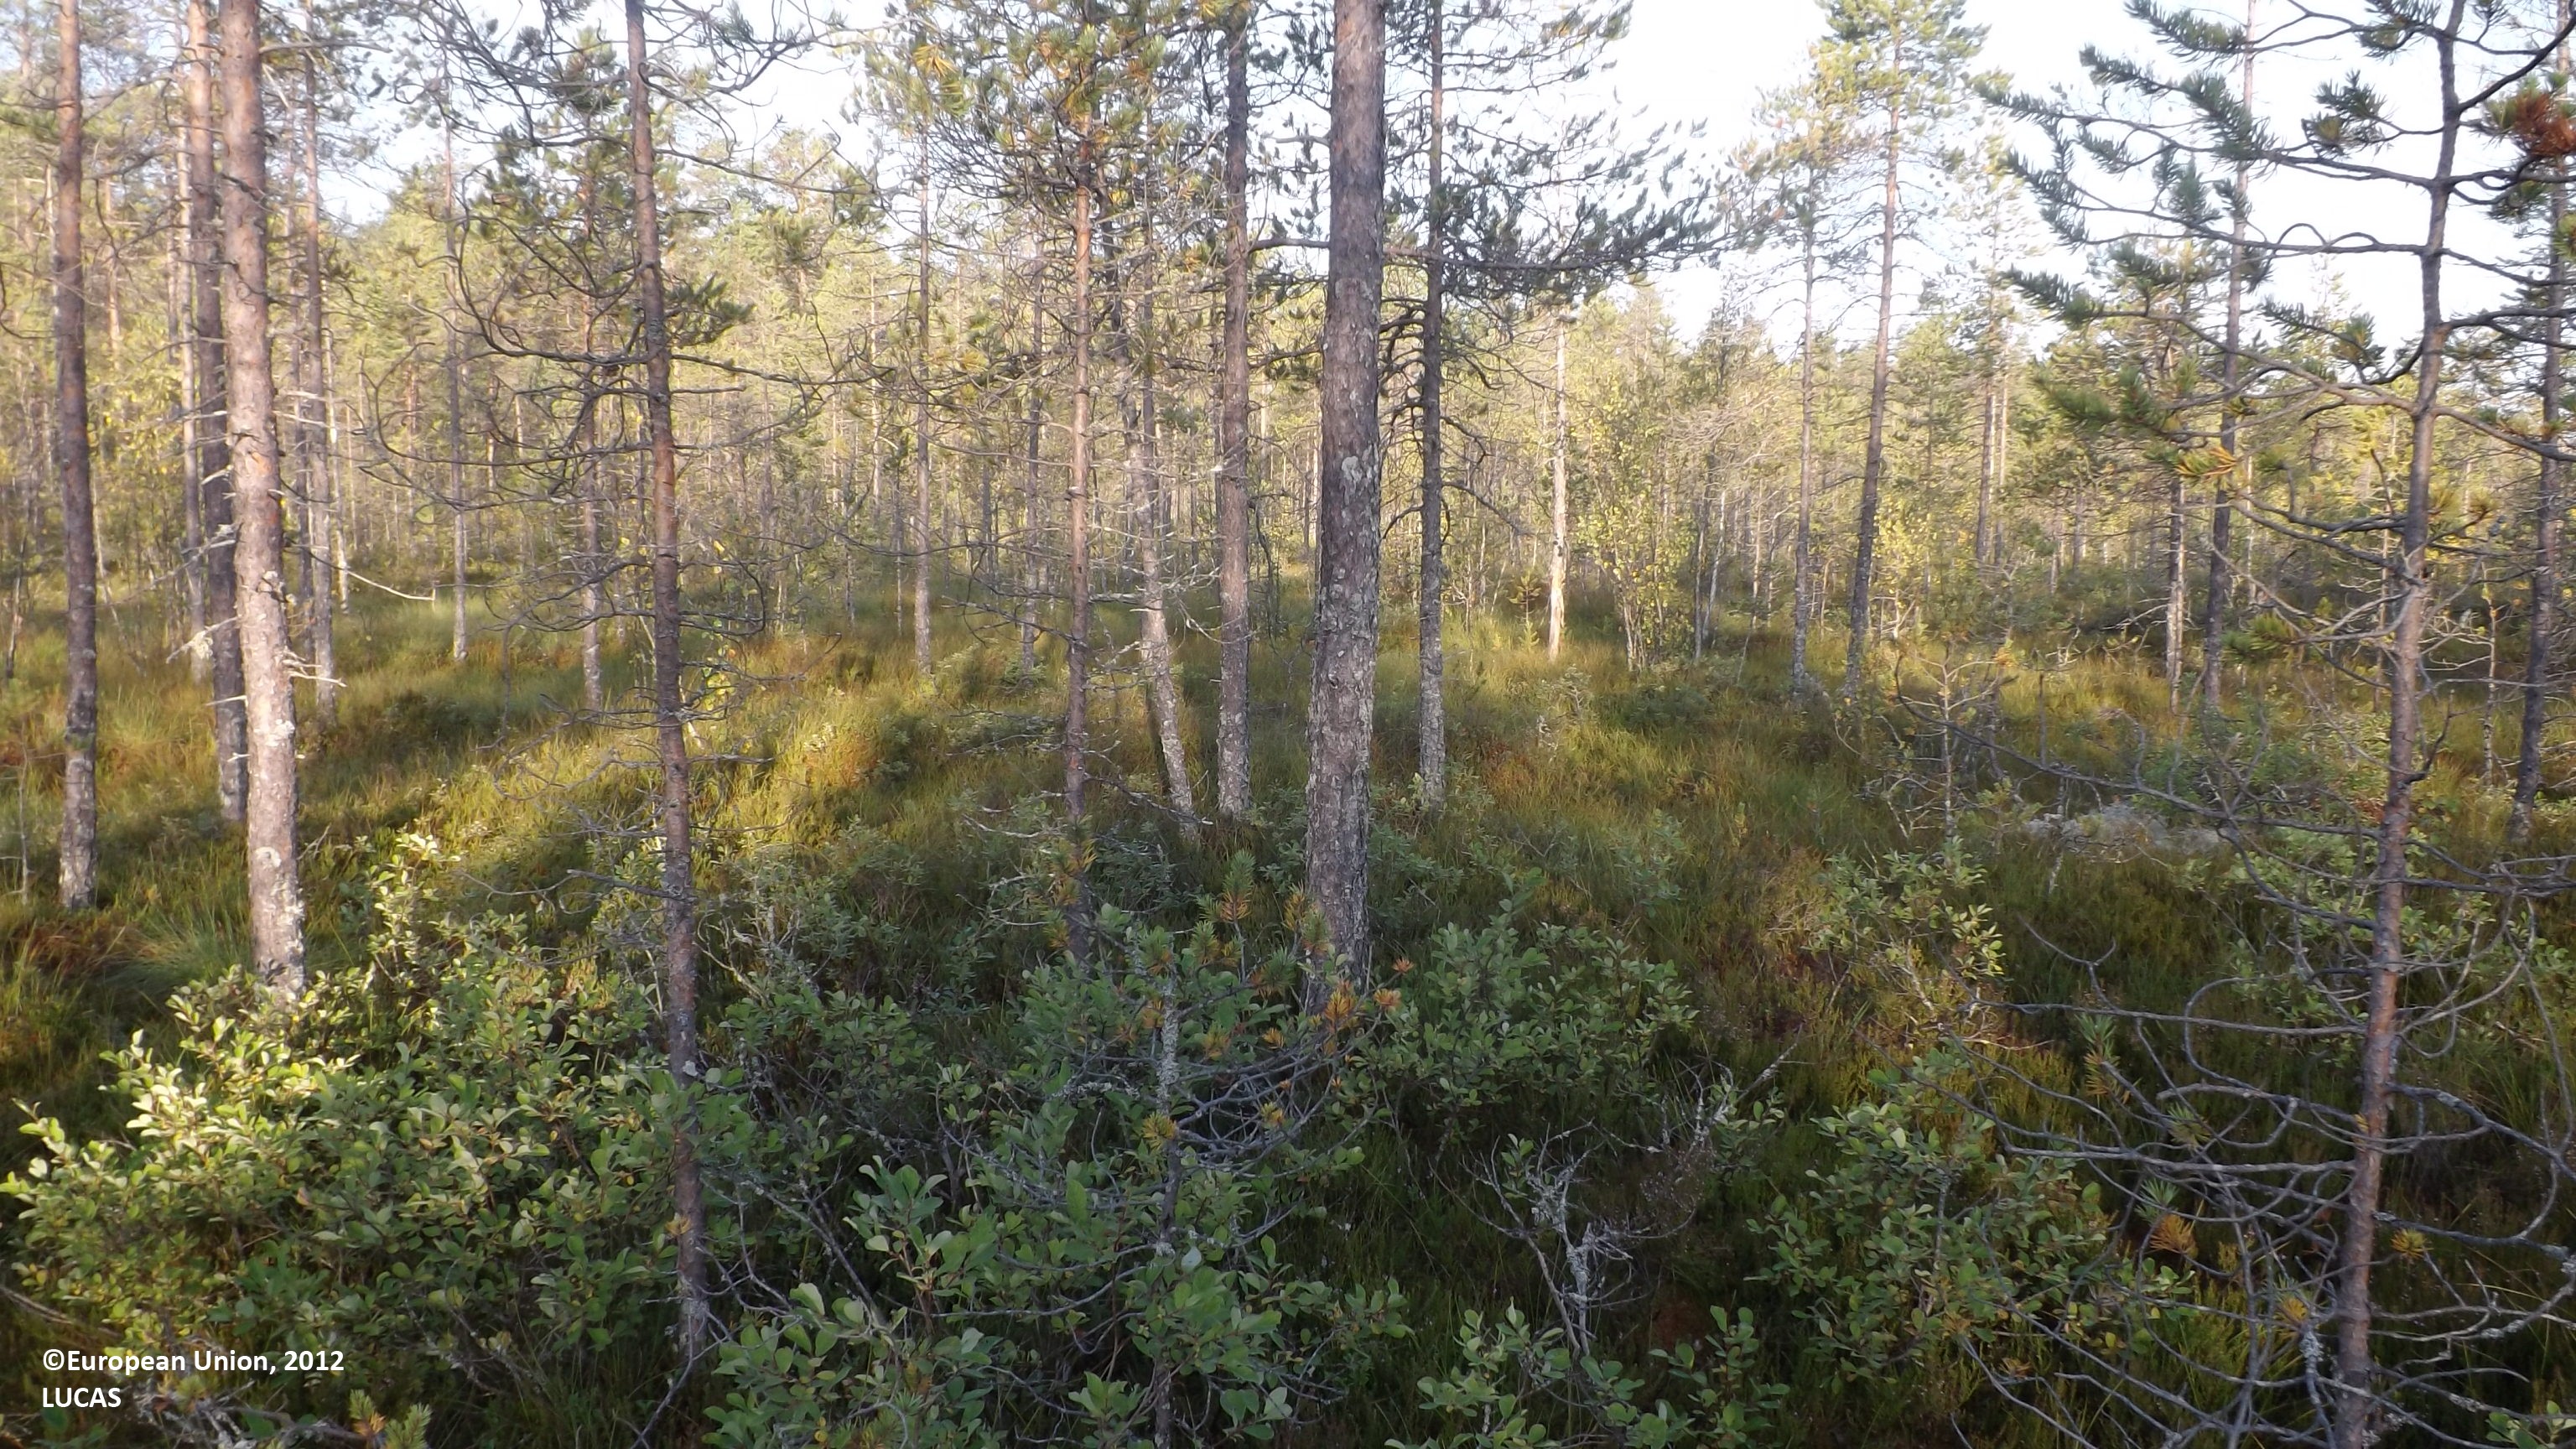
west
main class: Woodland
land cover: Pine dominated coniferous woodland
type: mire and swamp forests
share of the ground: 10 - 25 %
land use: Forestry
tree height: < 5 m
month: August
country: FI
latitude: 63.8015
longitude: 24.0979
